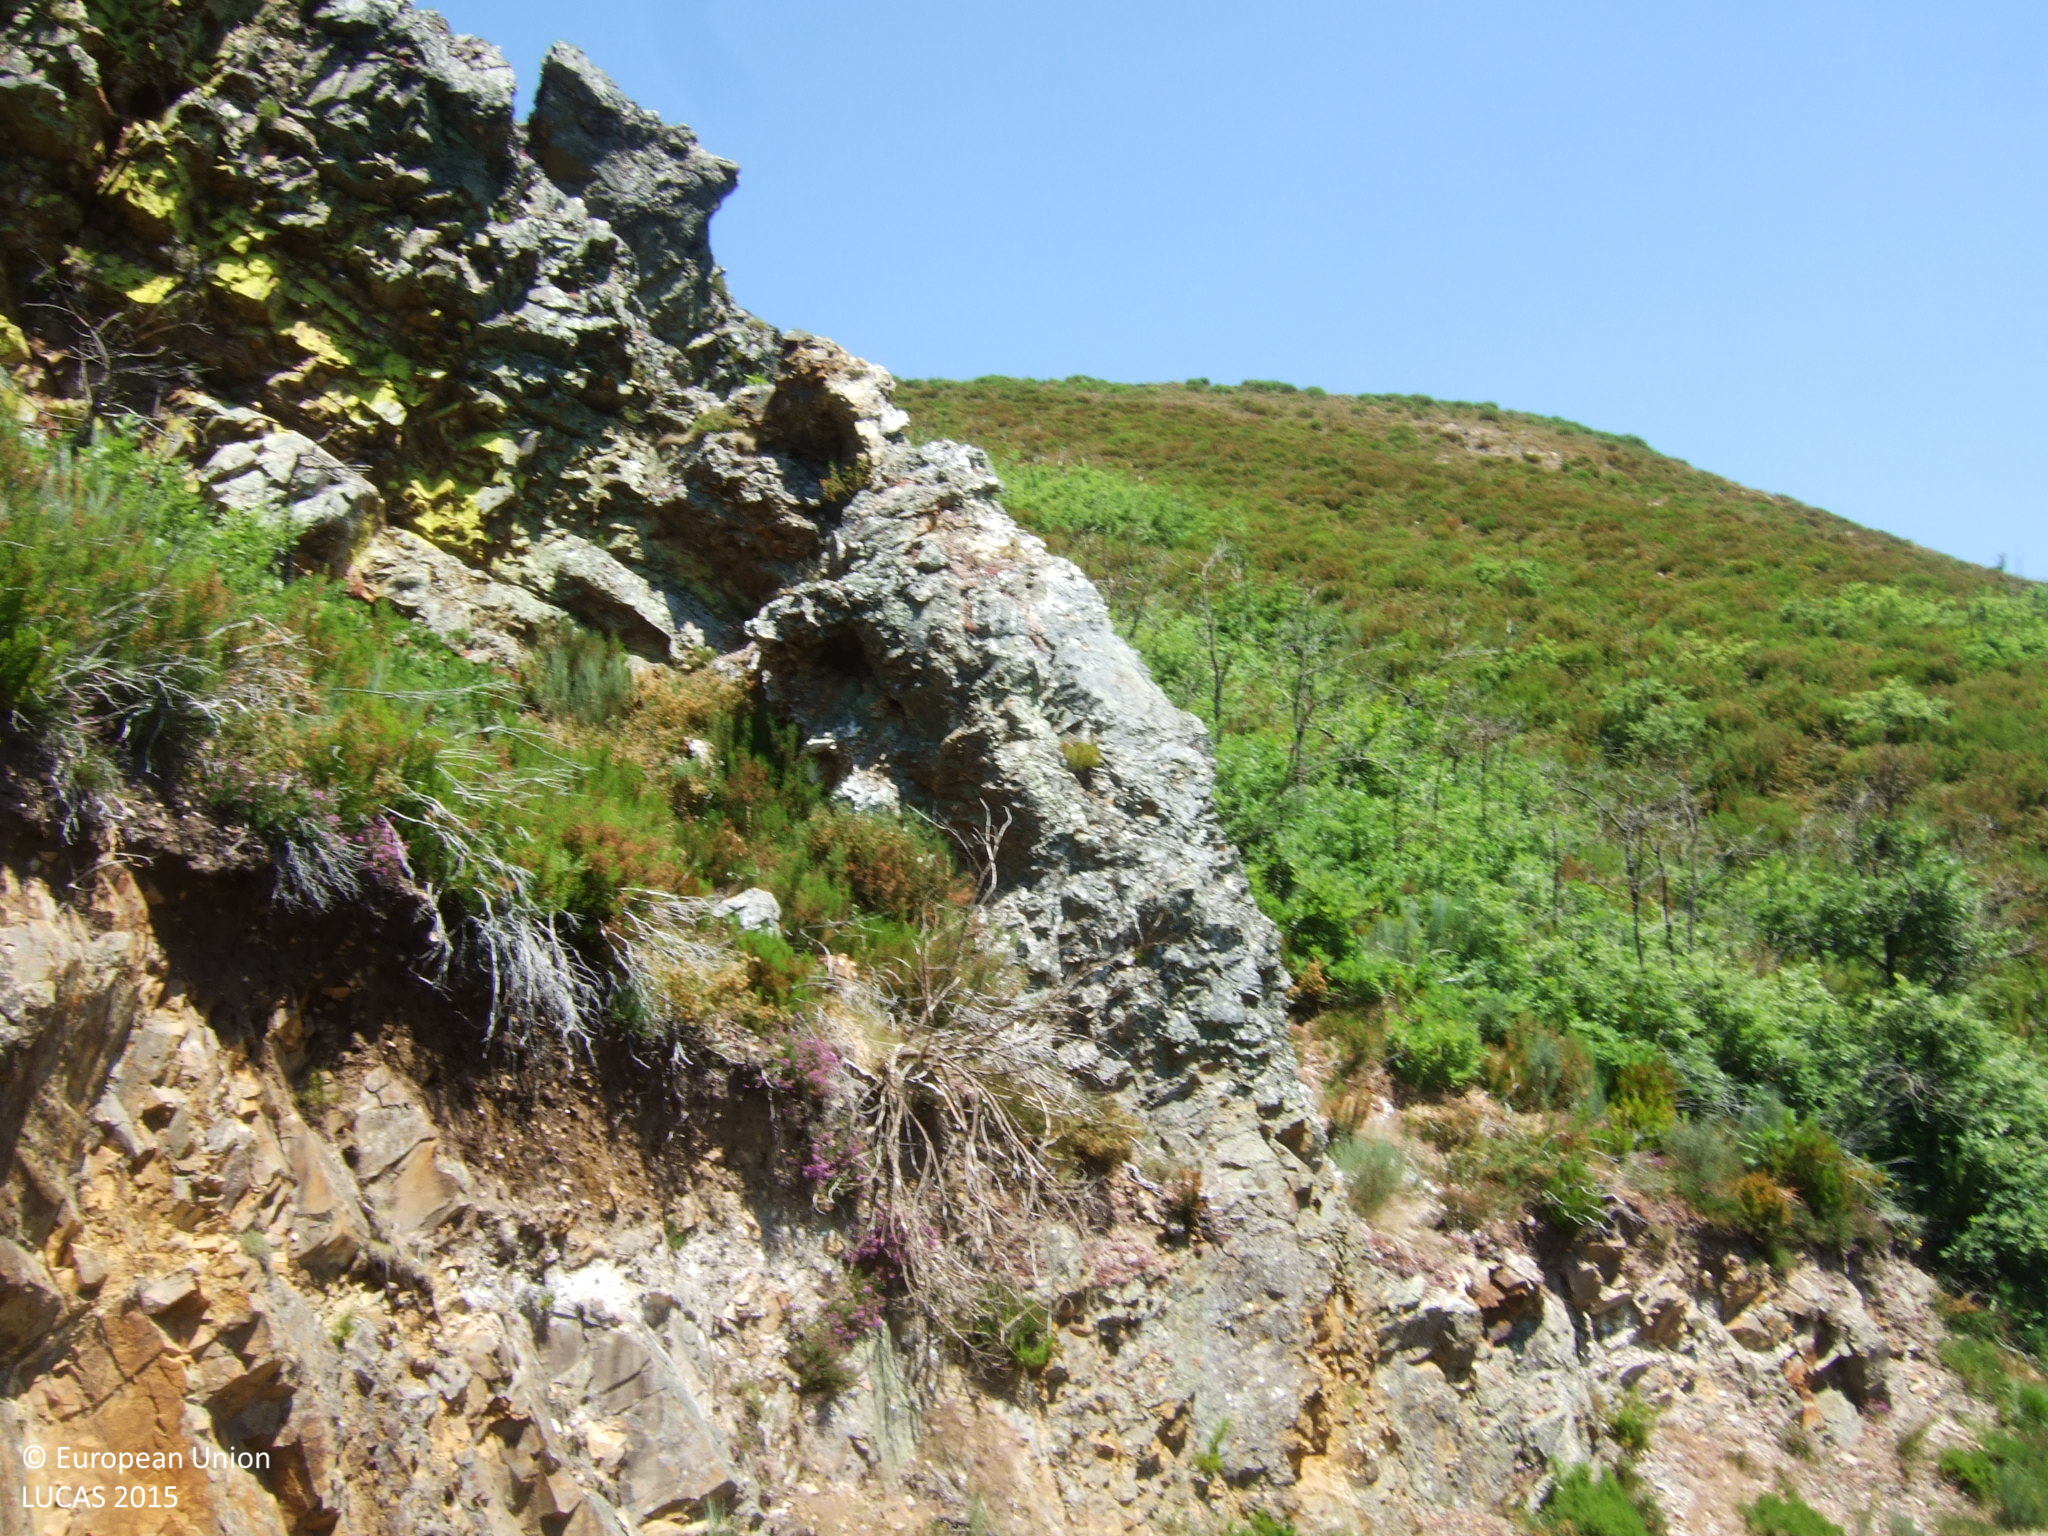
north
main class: Woodland
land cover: Broadleaved woodland
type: acidophilous oak and oak-birch forest
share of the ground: 25 - 50 %
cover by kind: shrubs 75 %, broadleaved forest trees 25 %
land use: Semi-natural and natural areas not in use
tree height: < 5 m
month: June
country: ES
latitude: 42.8542
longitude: -6.9347
